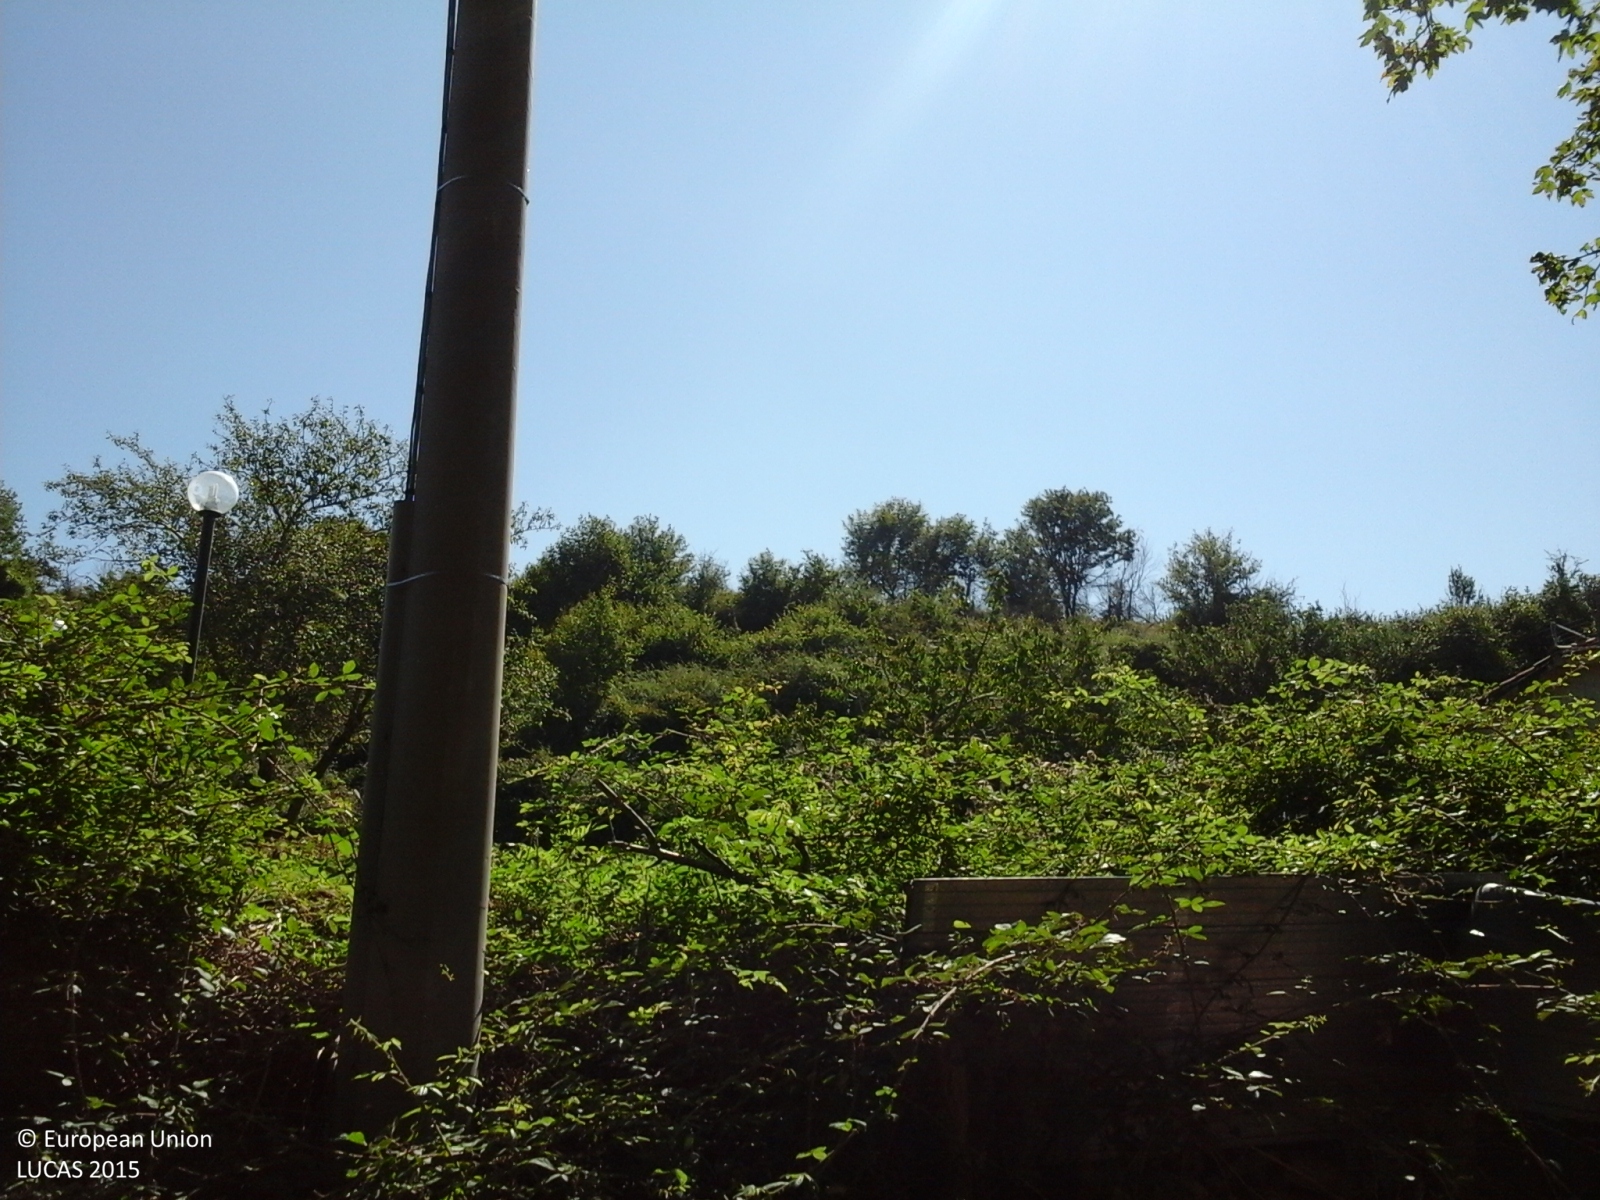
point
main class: Woodland
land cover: Broadleaved woodland
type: thermophilous deciduous forest
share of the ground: > 75 %
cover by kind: broadleaved forest trees 100 %
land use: Forestry
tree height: > 5 m
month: August
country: IT
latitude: 41.9070
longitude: 12.9188
